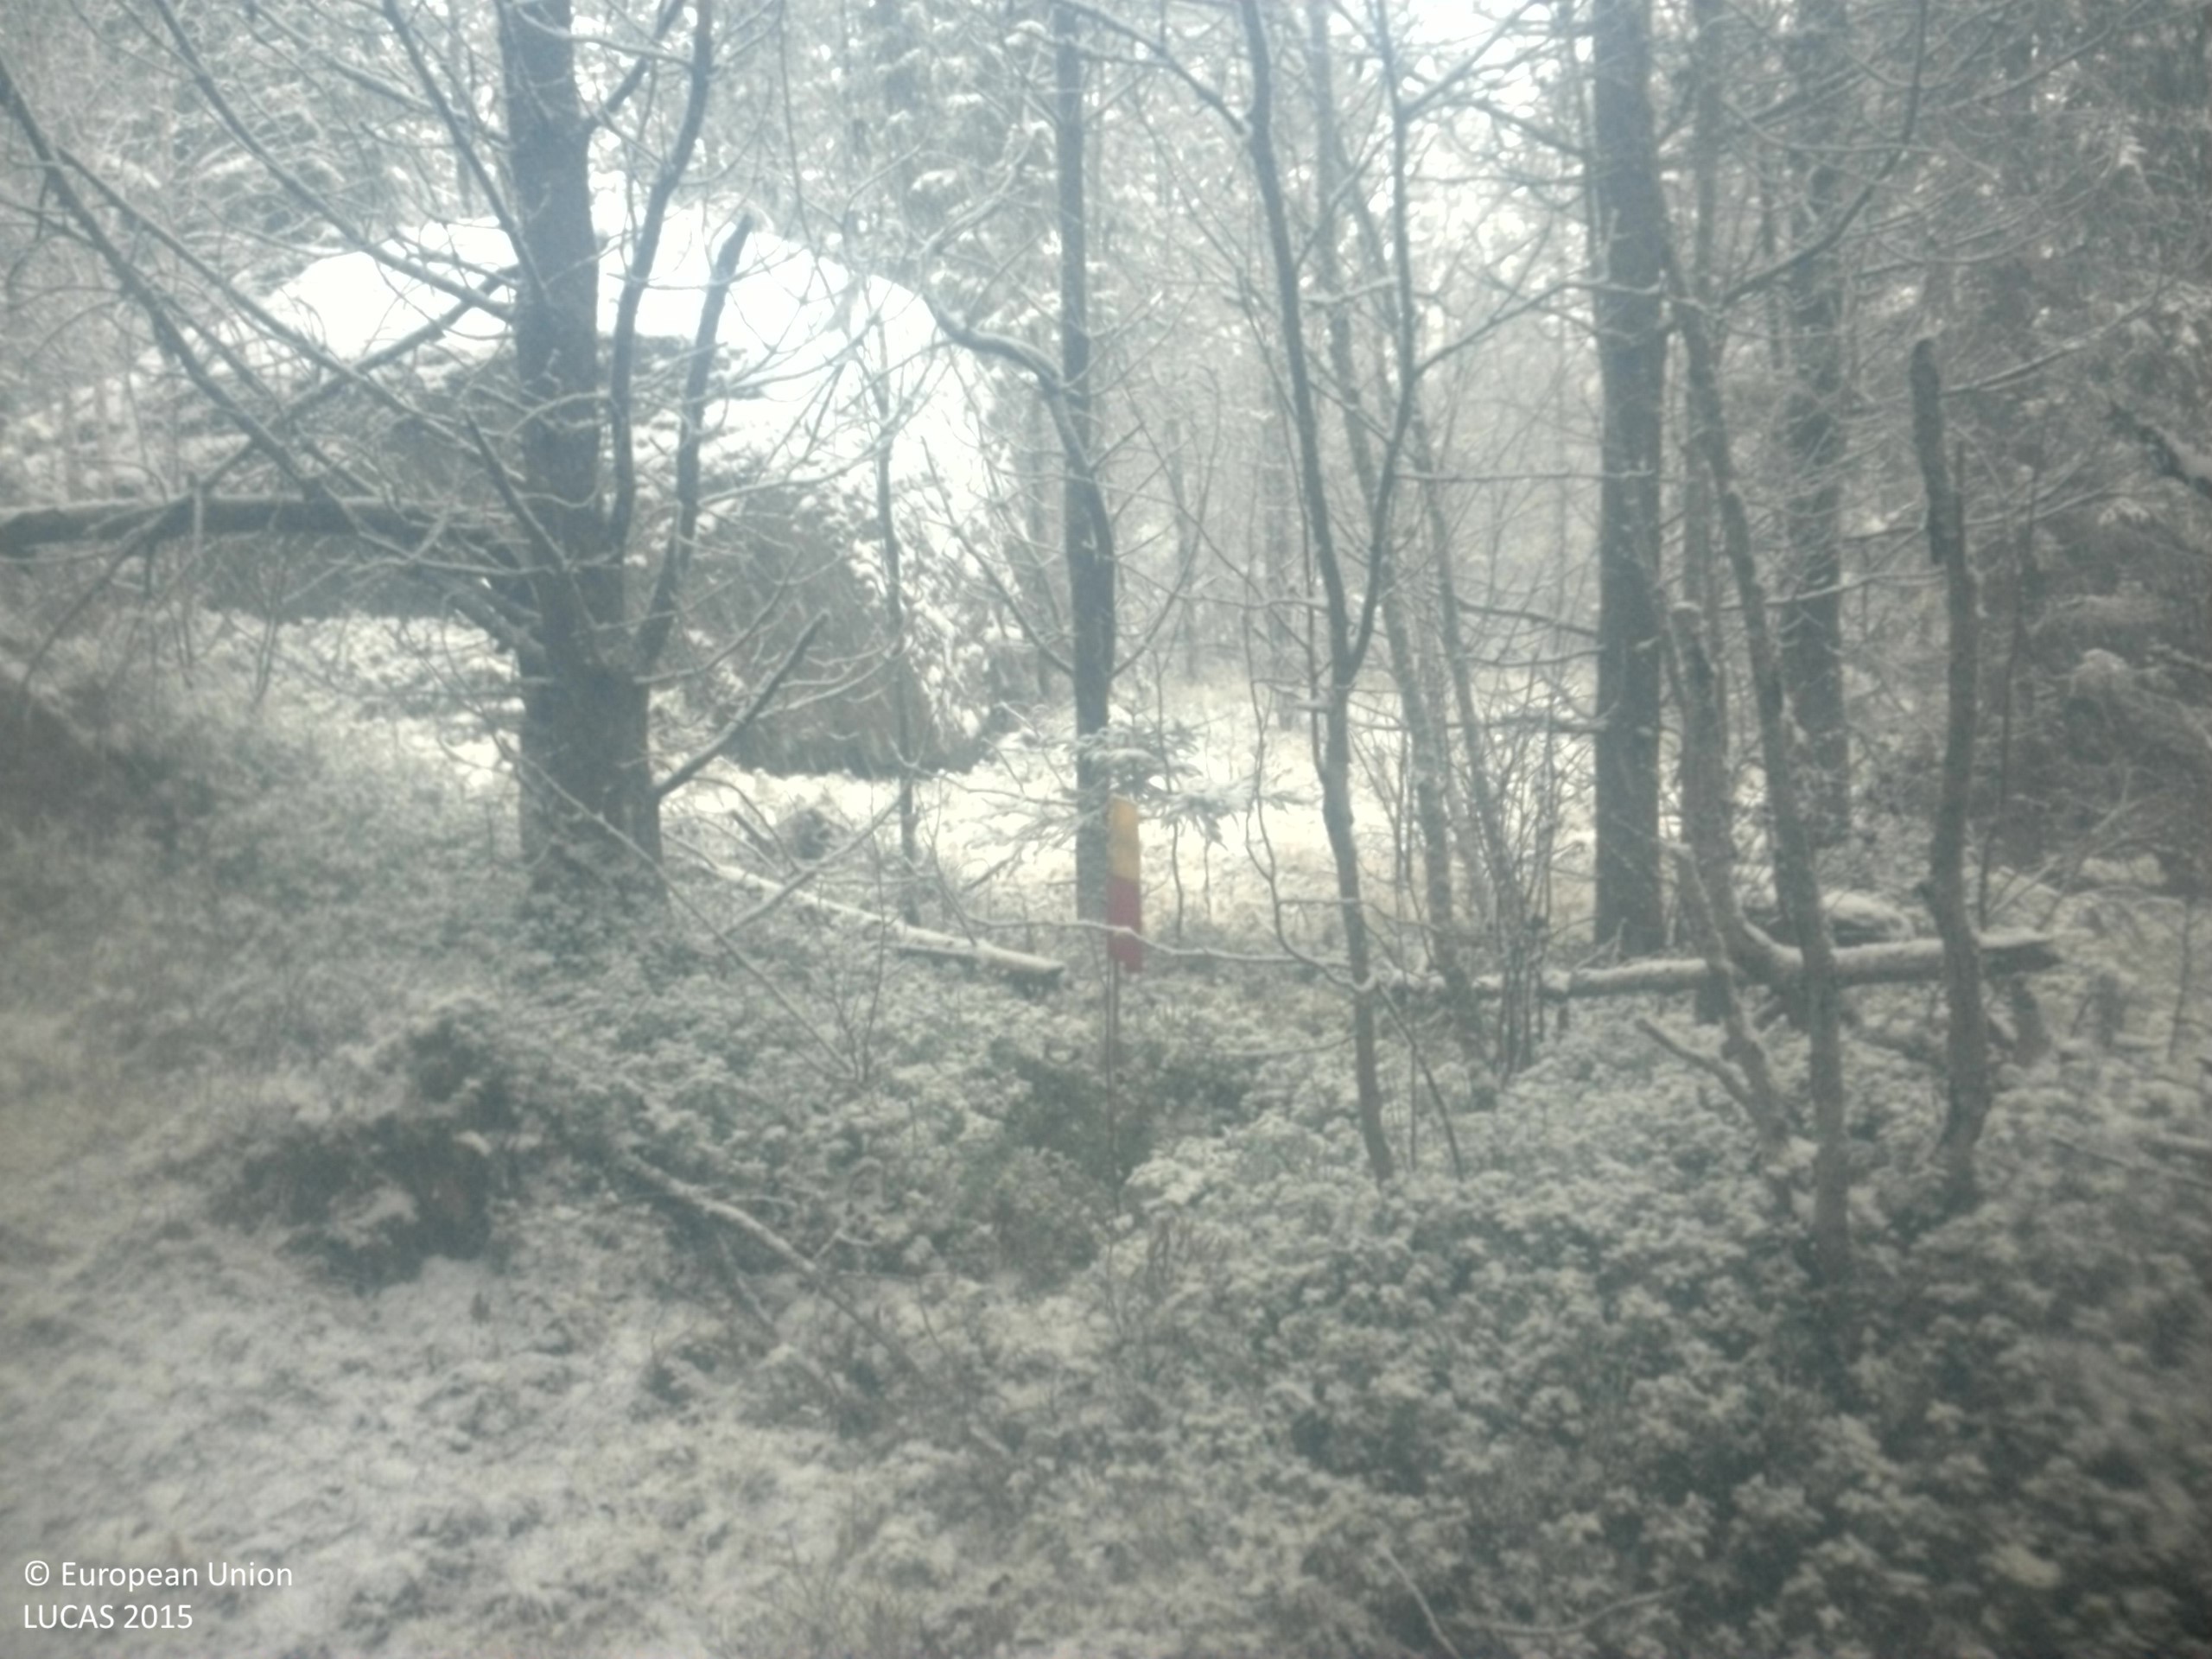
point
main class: Woodland
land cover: Pine dominated mixed woodland
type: exotic forest
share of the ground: 50 - 75 %
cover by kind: coniferous forest trees 45 %, shrubs 20 %, broadleaved forest trees 15 %, lichens and mosses 15 %, herbaceous plants 5 %
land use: Forestry
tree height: > 5 m
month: November
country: SE
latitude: 63.7269
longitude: 15.9061
